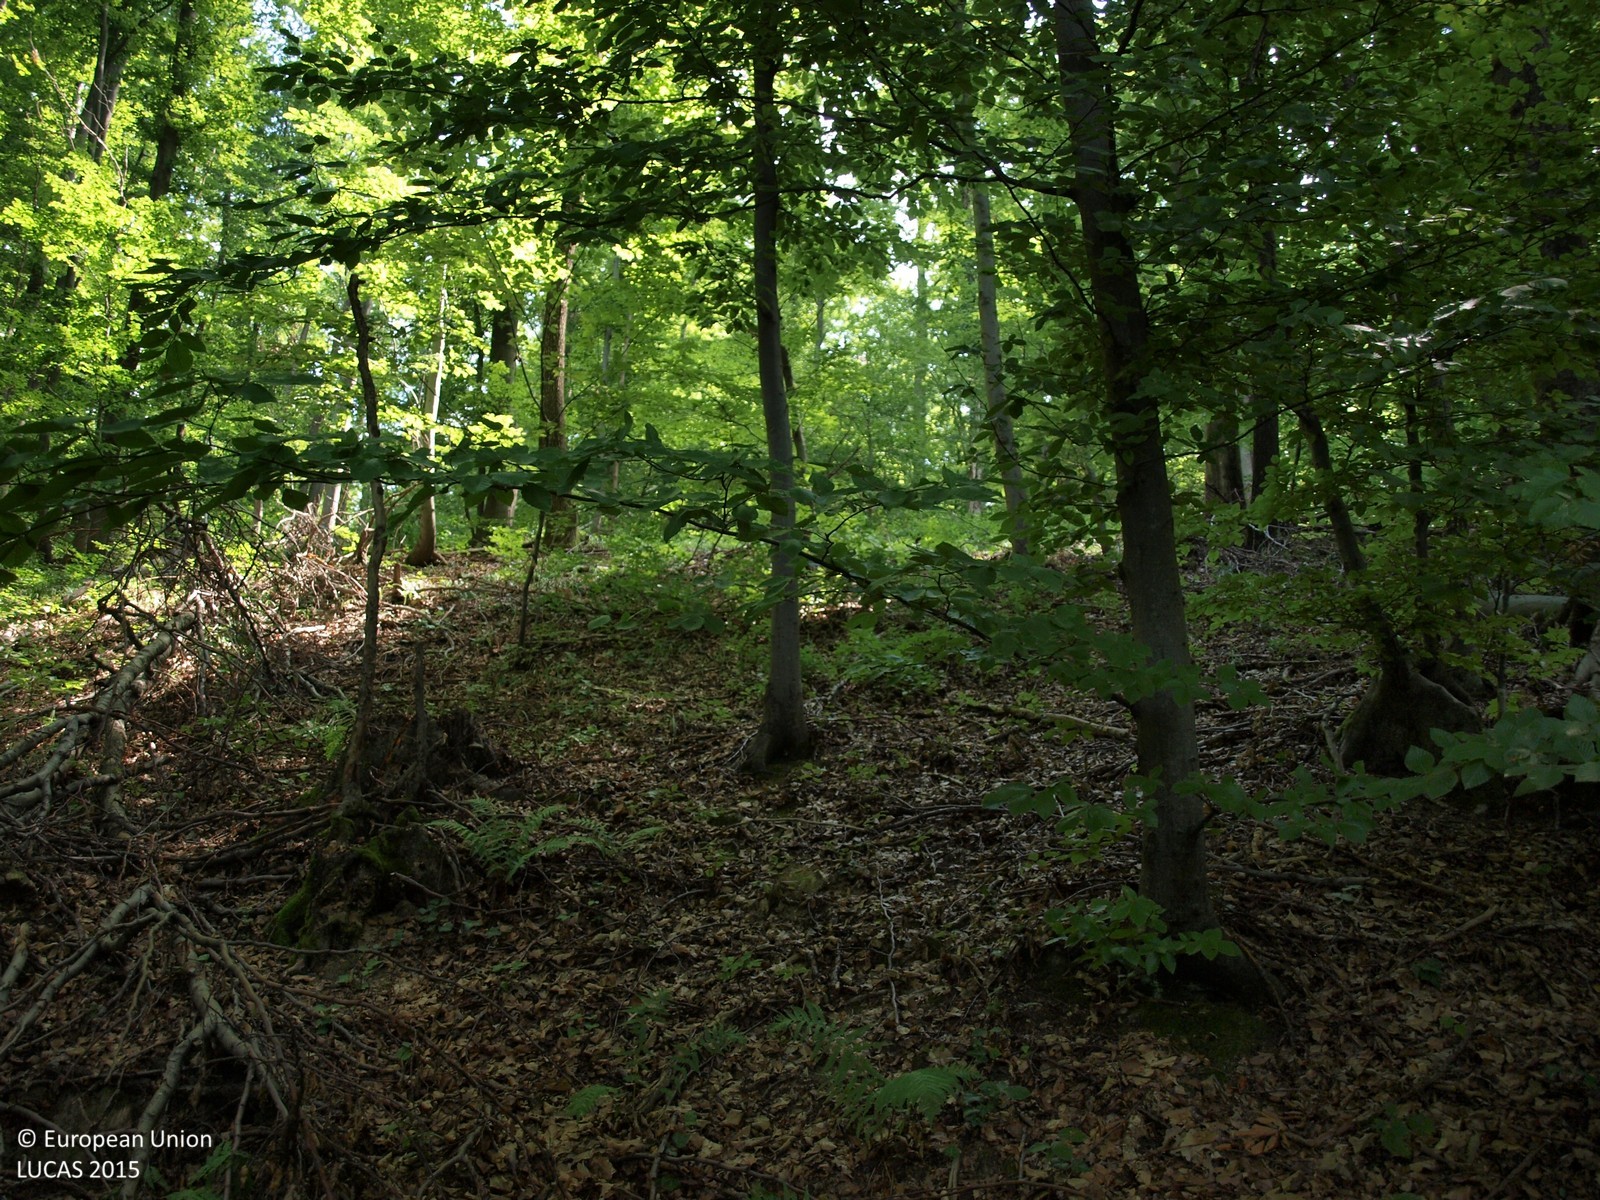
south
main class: Woodland
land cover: Broadleaved woodland
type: beech forest
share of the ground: > 75 %
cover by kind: broadleaved forest trees 100 %
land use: Forestry
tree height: > 5 m
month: July
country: HR
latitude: 45.9932
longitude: 16.1573
